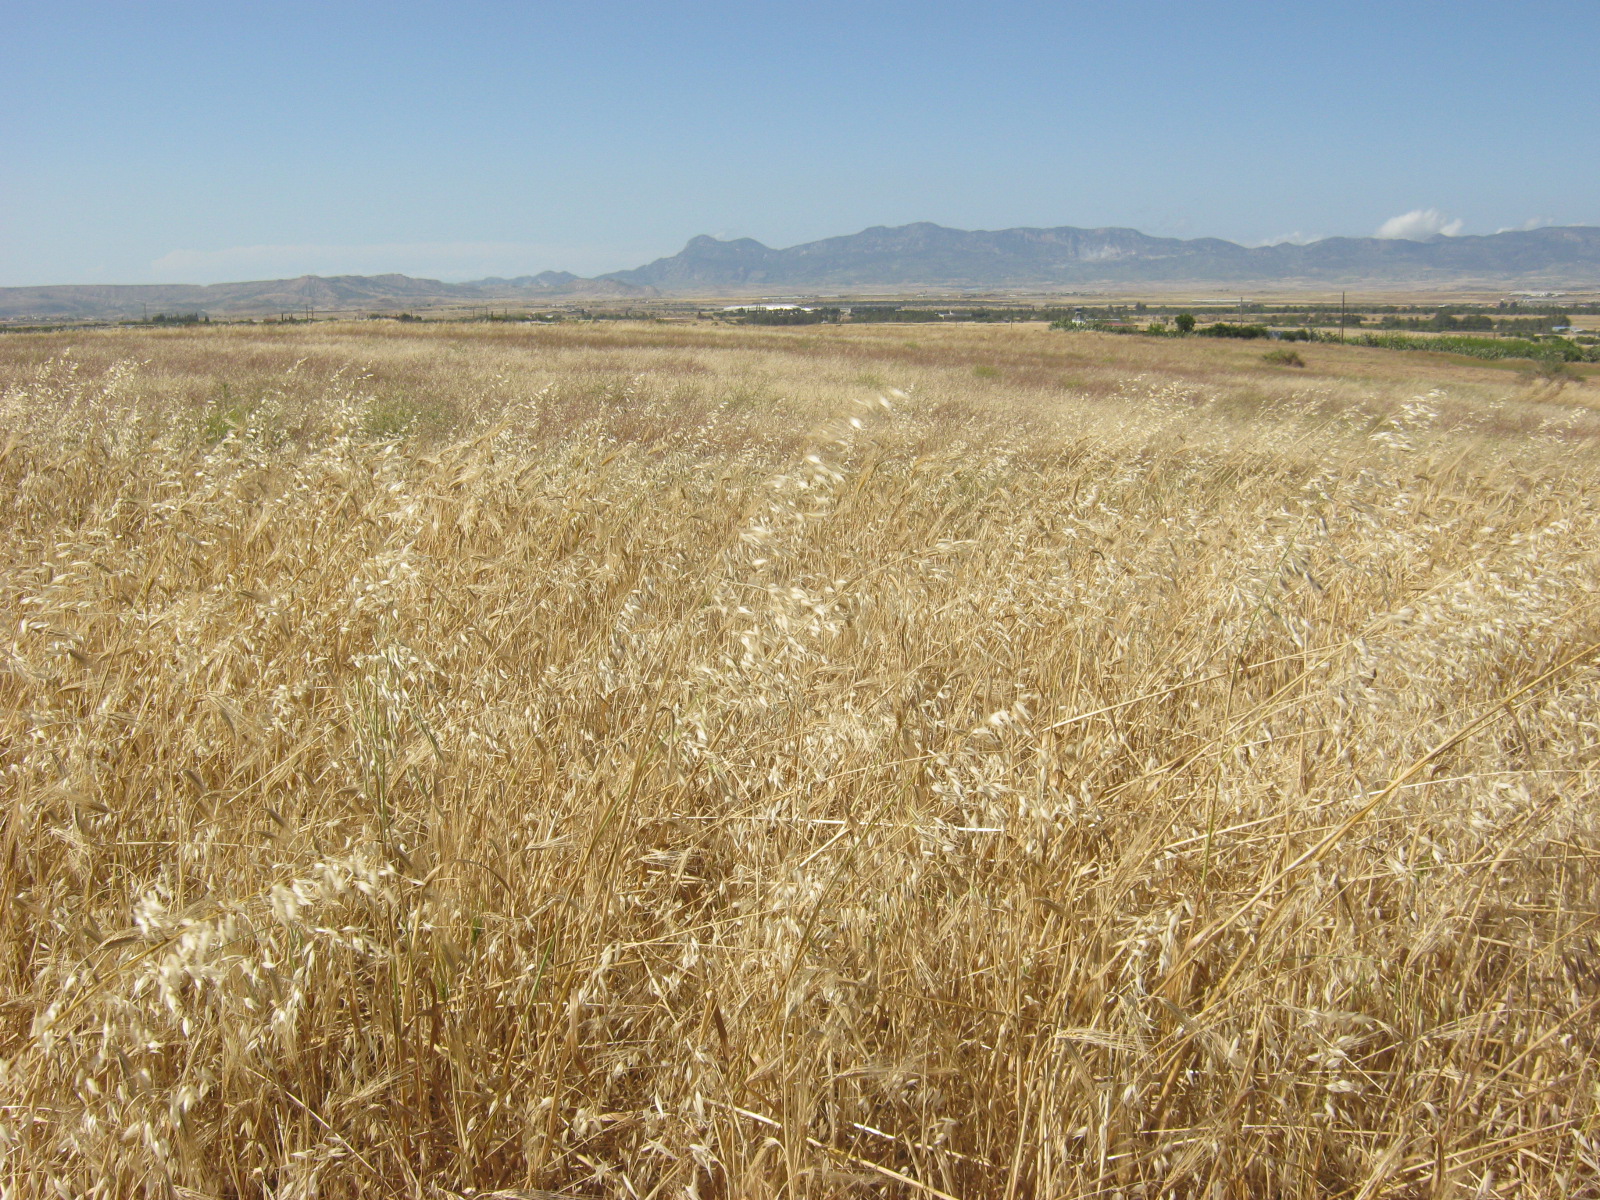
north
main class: Cropland
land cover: Barley
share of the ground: > 75 %
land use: Agriculture (excluding fallow land and kitchen gardens)
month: May
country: CY
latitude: 35.1244
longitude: 33.1742
